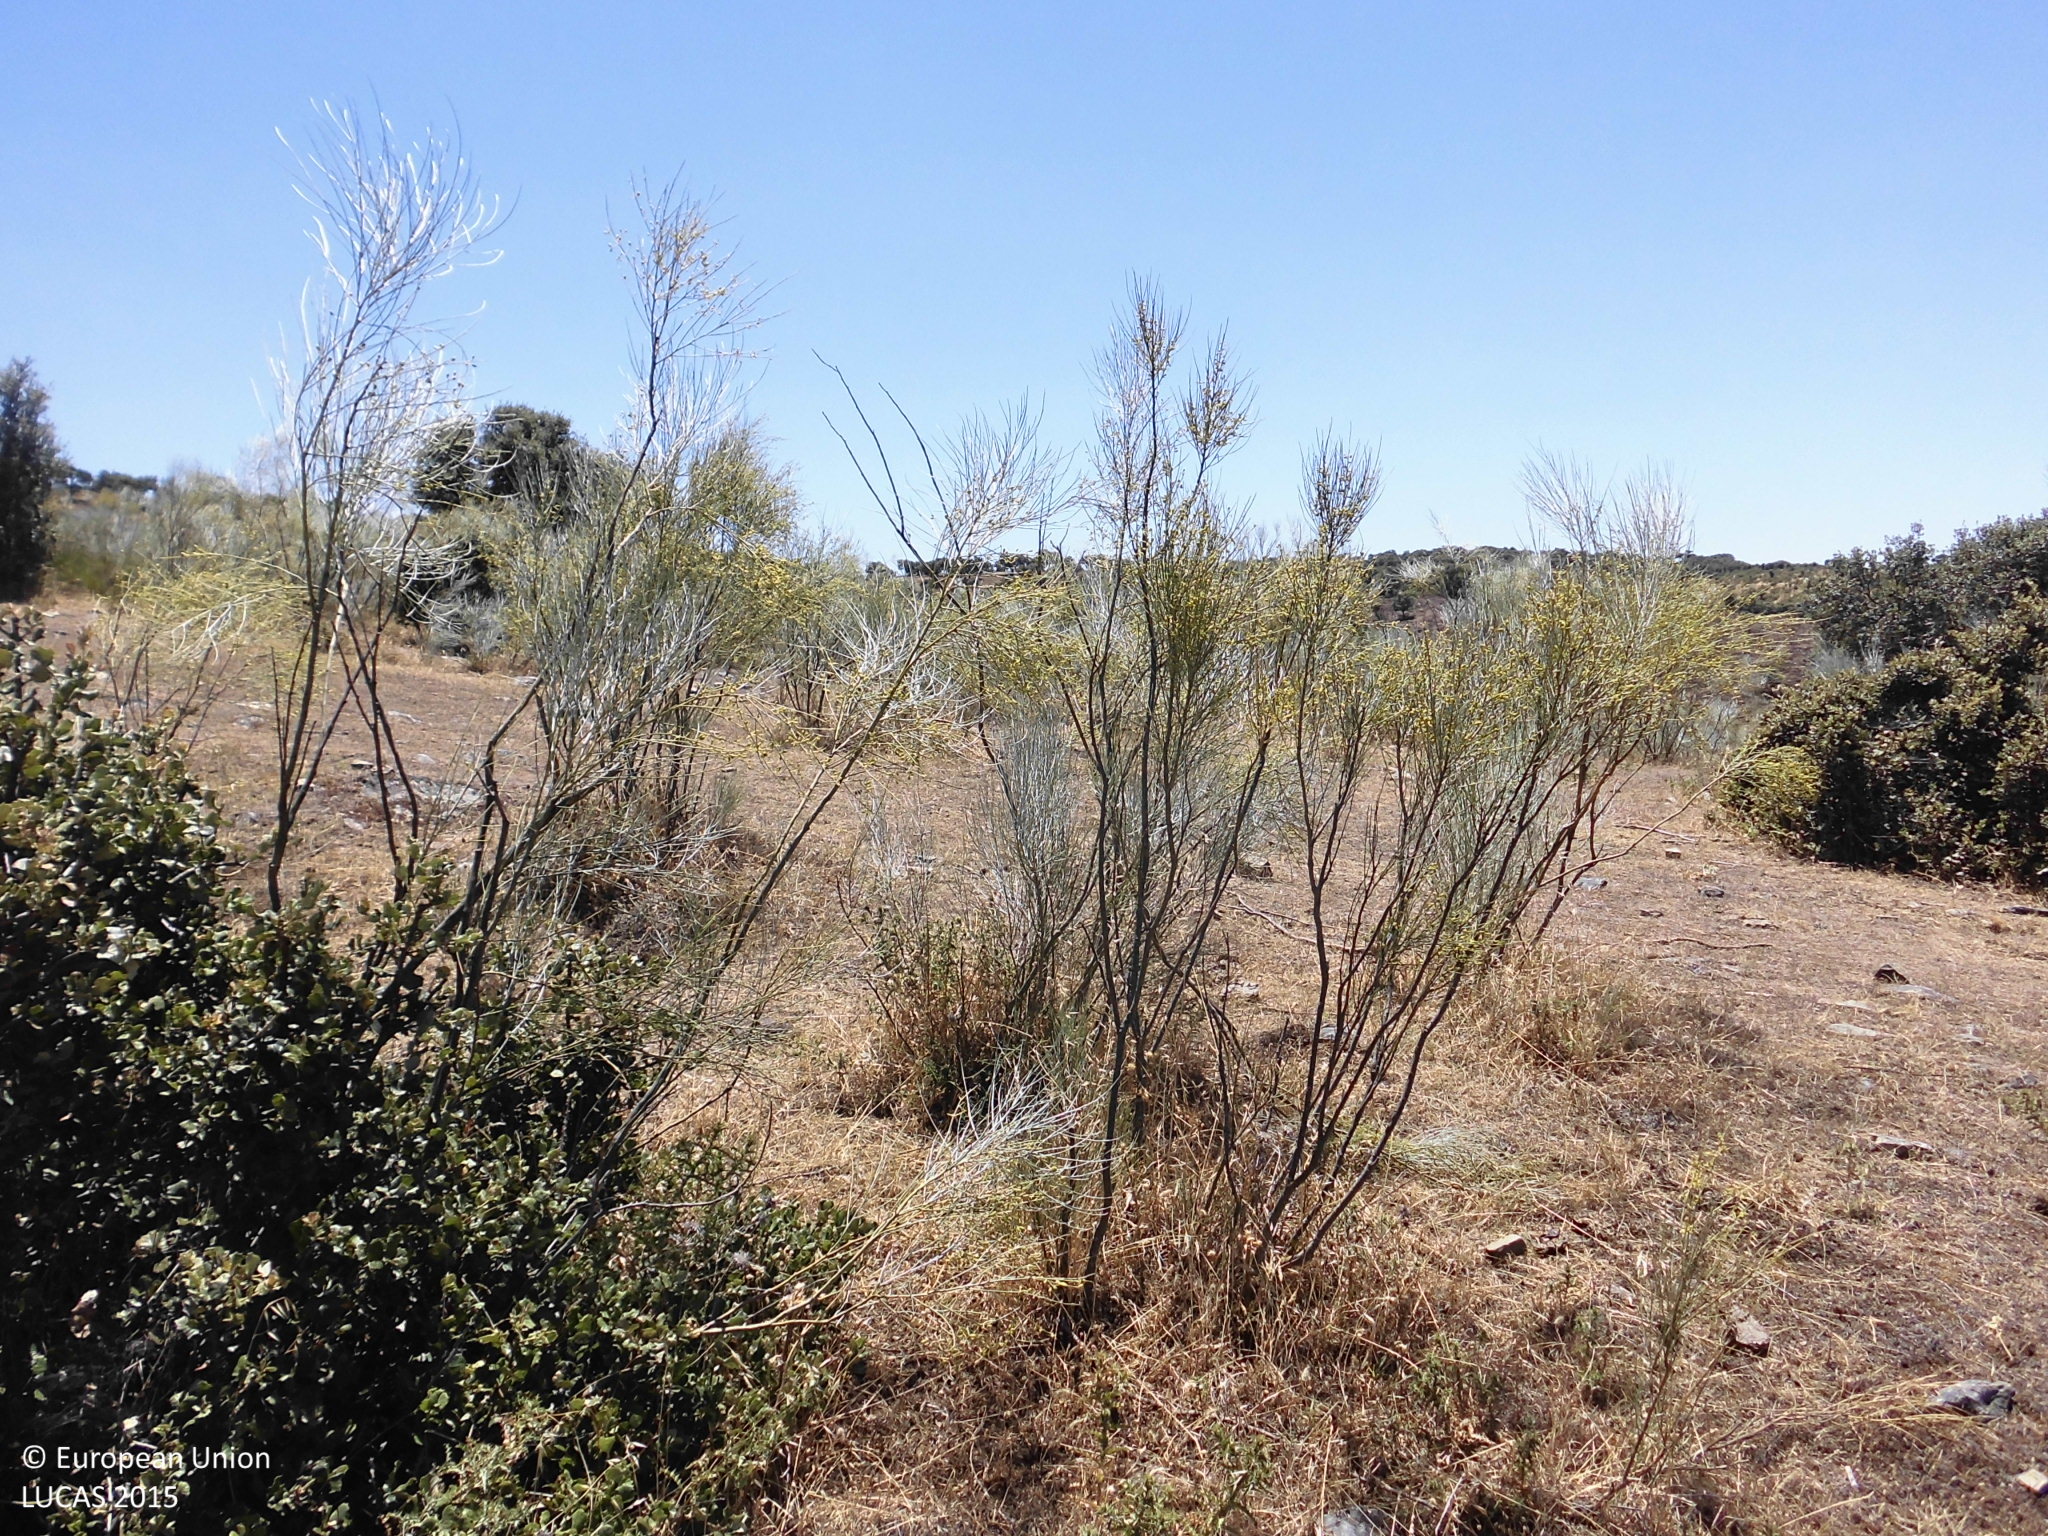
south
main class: Shrubland
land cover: Shrubland without tree cover
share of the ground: 10 - 25 %
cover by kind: herbaceous plants 85 %, shrubs 15 %
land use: Agriculture (excluding fallow land and kitchen gardens)
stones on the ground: > 50 %
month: June
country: ES
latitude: 39.9944
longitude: -6.1054
